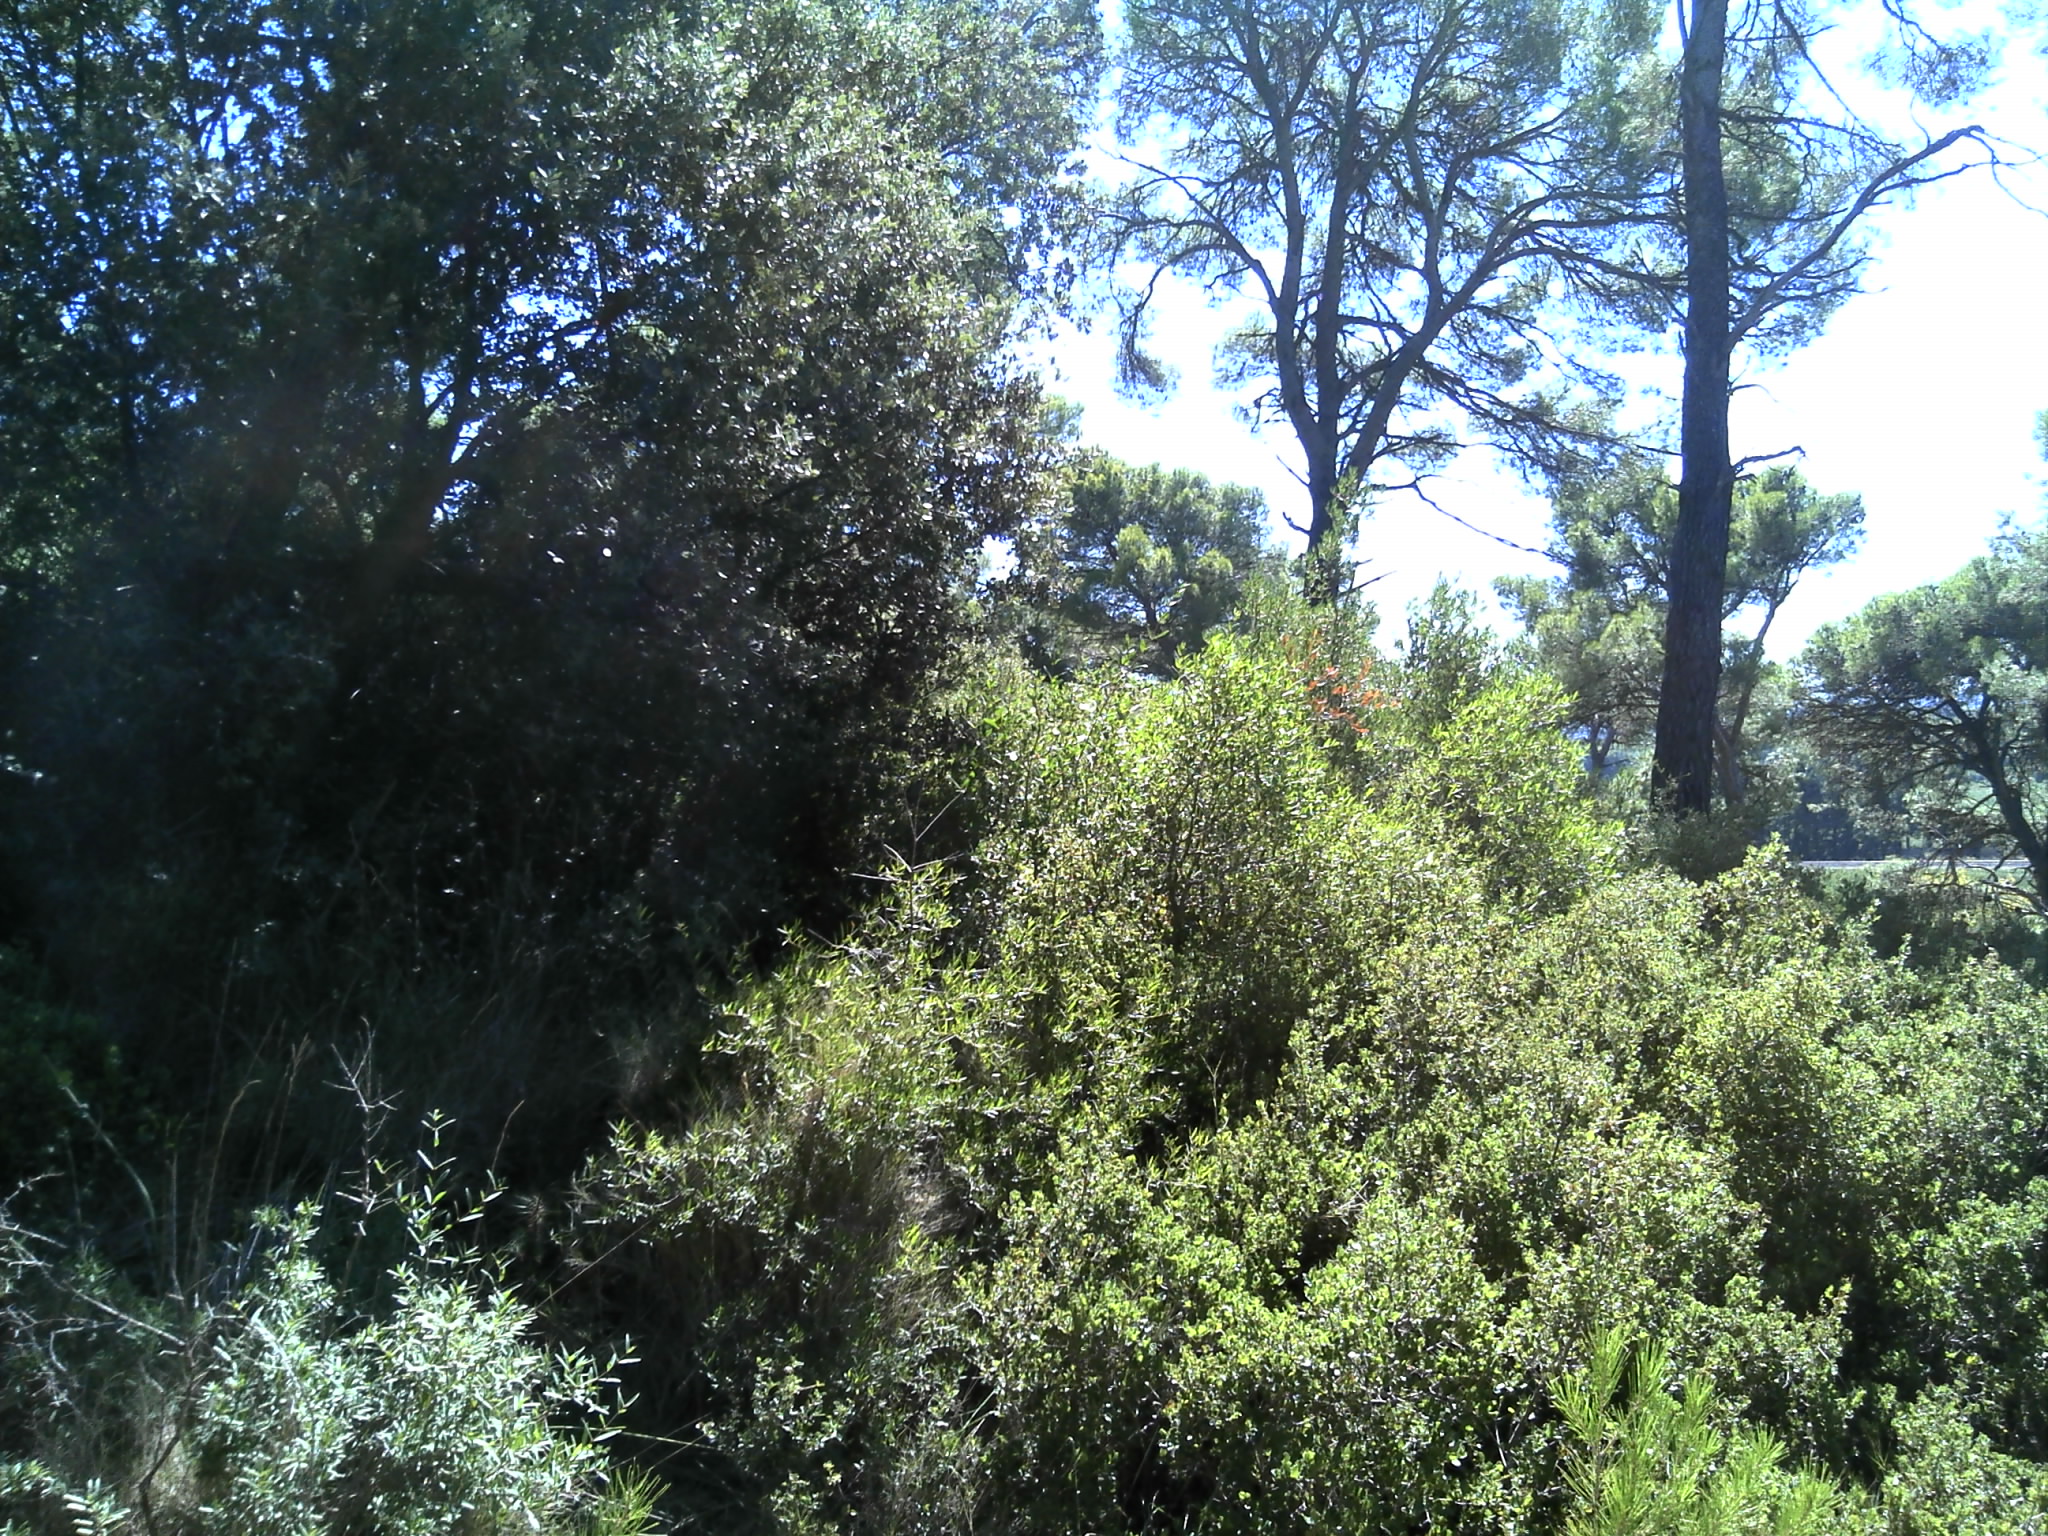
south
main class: Woodland
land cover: Pine dominated coniferous woodland
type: coniferous forest of the mediterranean region
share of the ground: 50 - 75 %
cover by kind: coniferous forest trees 50 %, shrubs 30 %, herbaceous plants 20 %
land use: Forestry
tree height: > 5 m
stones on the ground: < 10 %
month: September
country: FR
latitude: 43.7663
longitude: 5.1272
